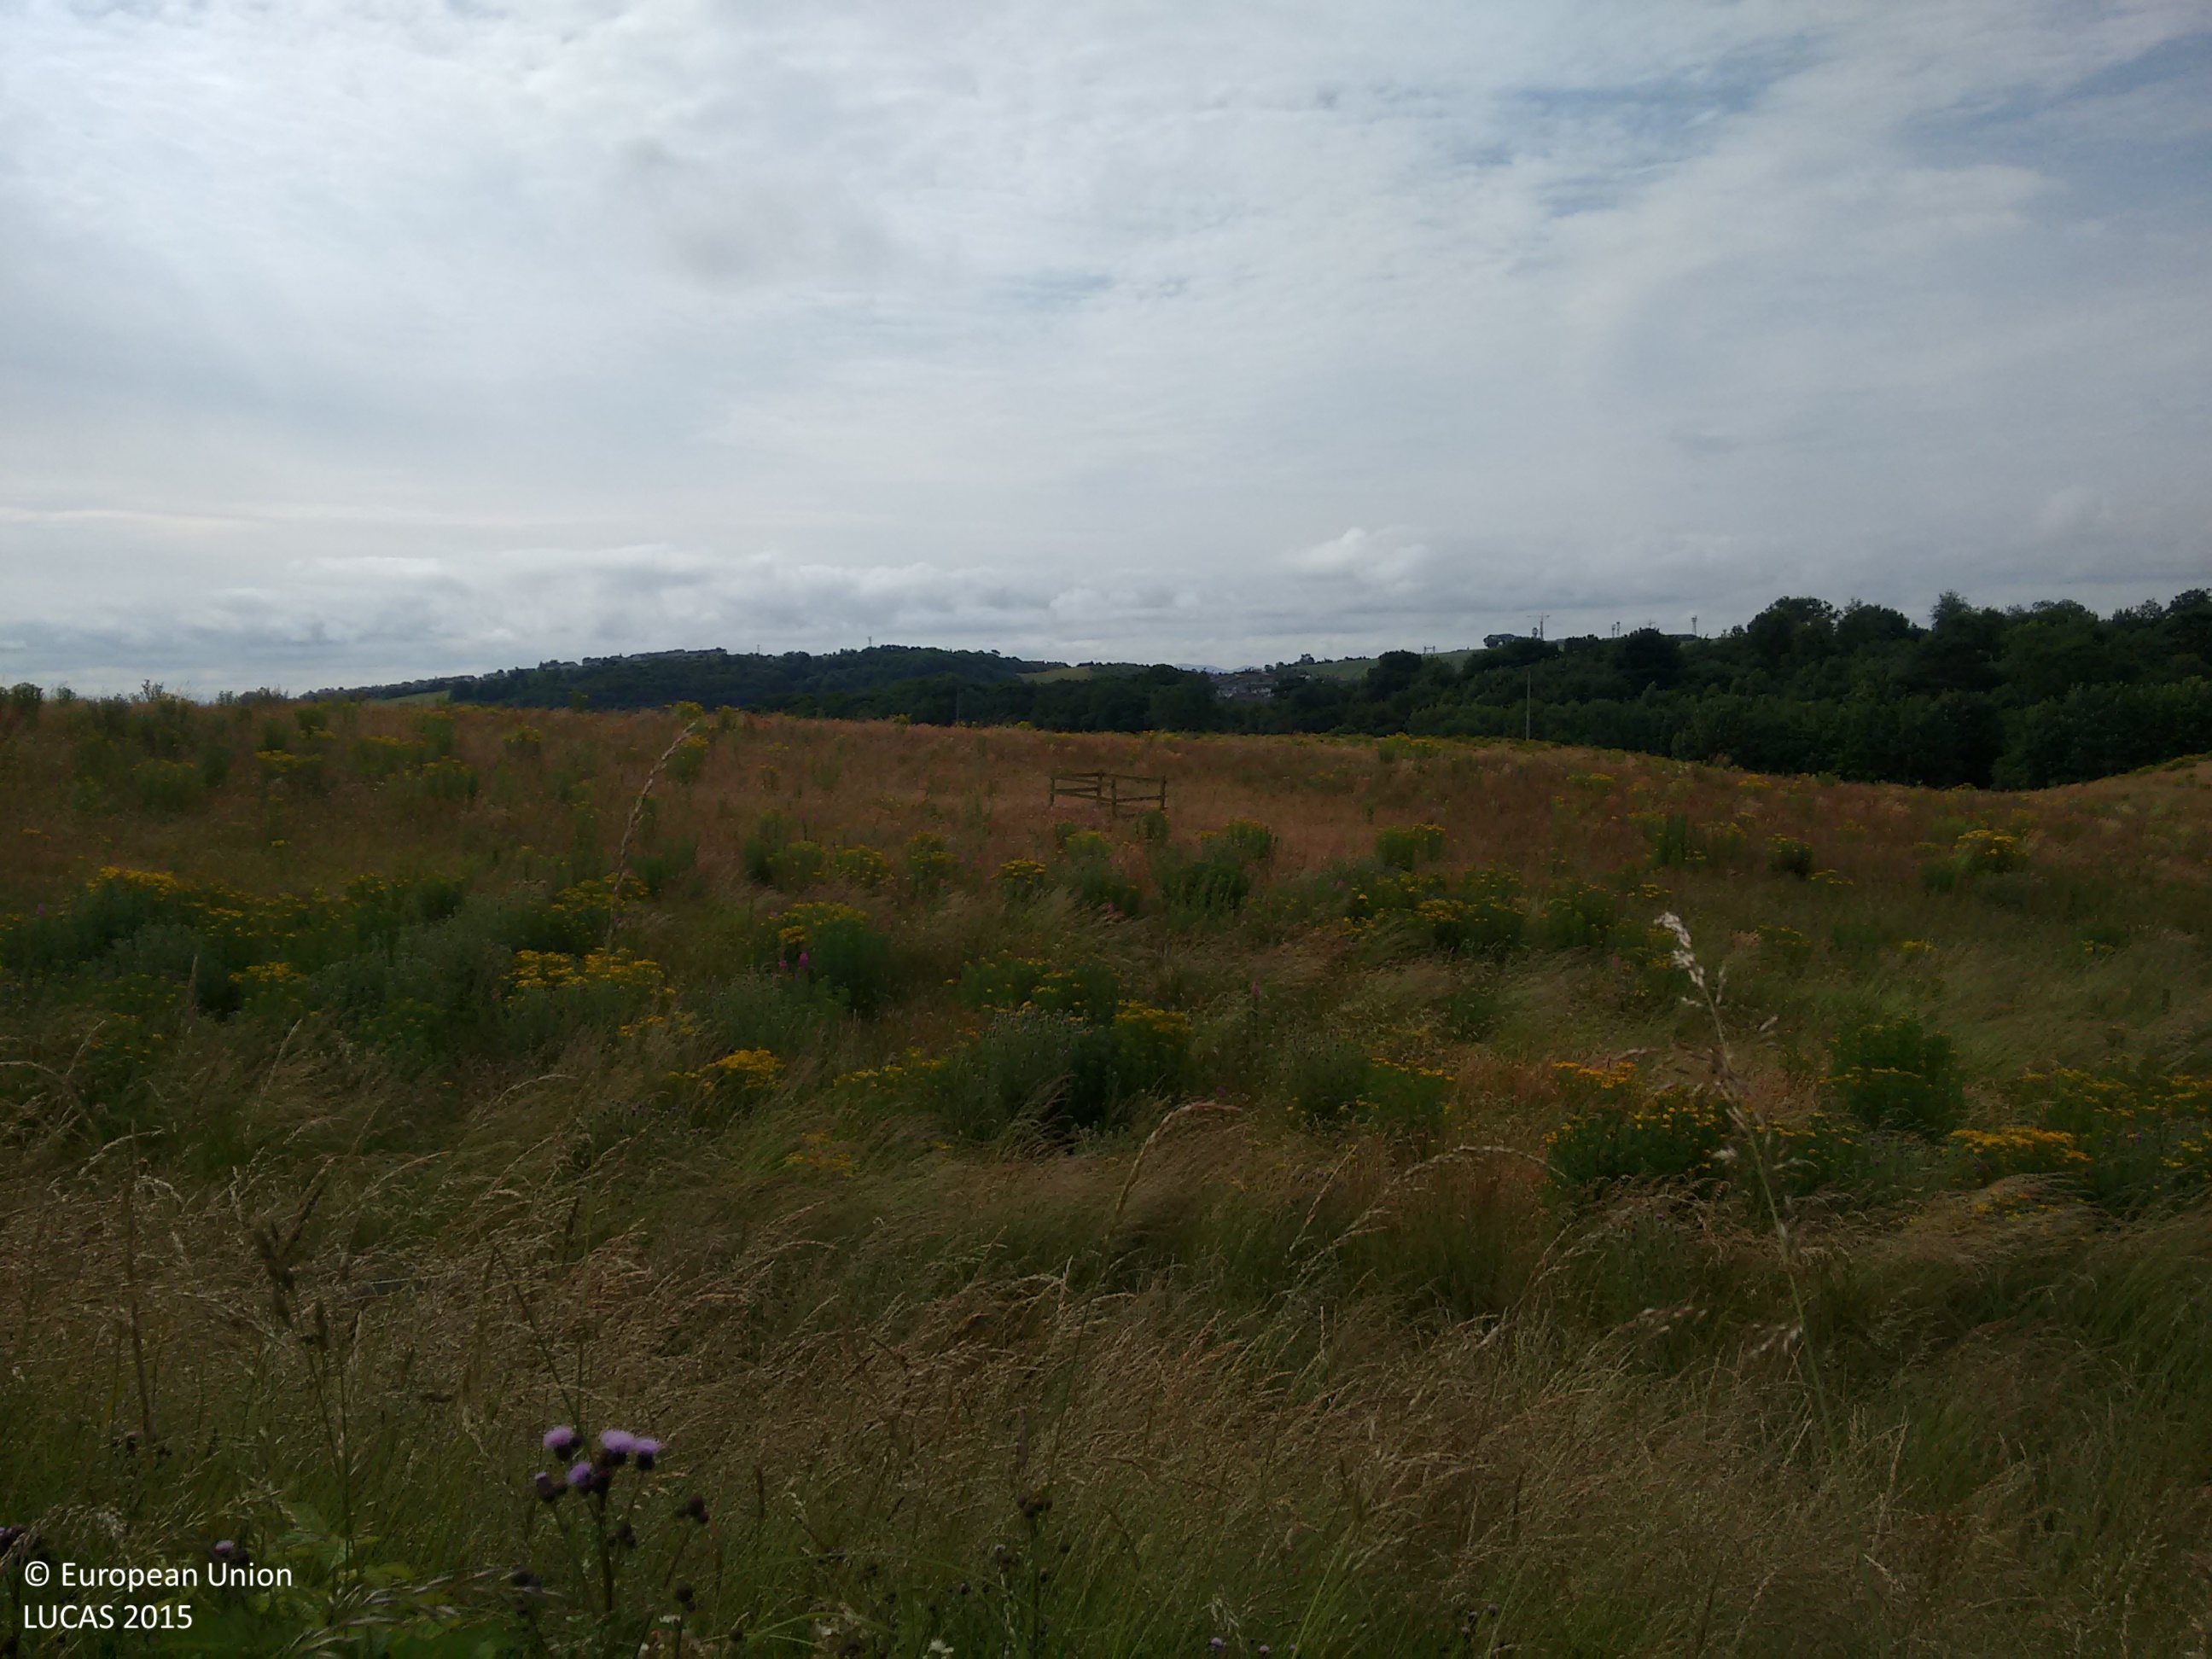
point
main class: Grassland
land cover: Grassland without tree/shrub cover
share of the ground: > 75 %
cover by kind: herbaceous plants 100 %
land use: Semi-natural and natural areas not in use
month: July
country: GB
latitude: 56.0449
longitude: -3.4157
